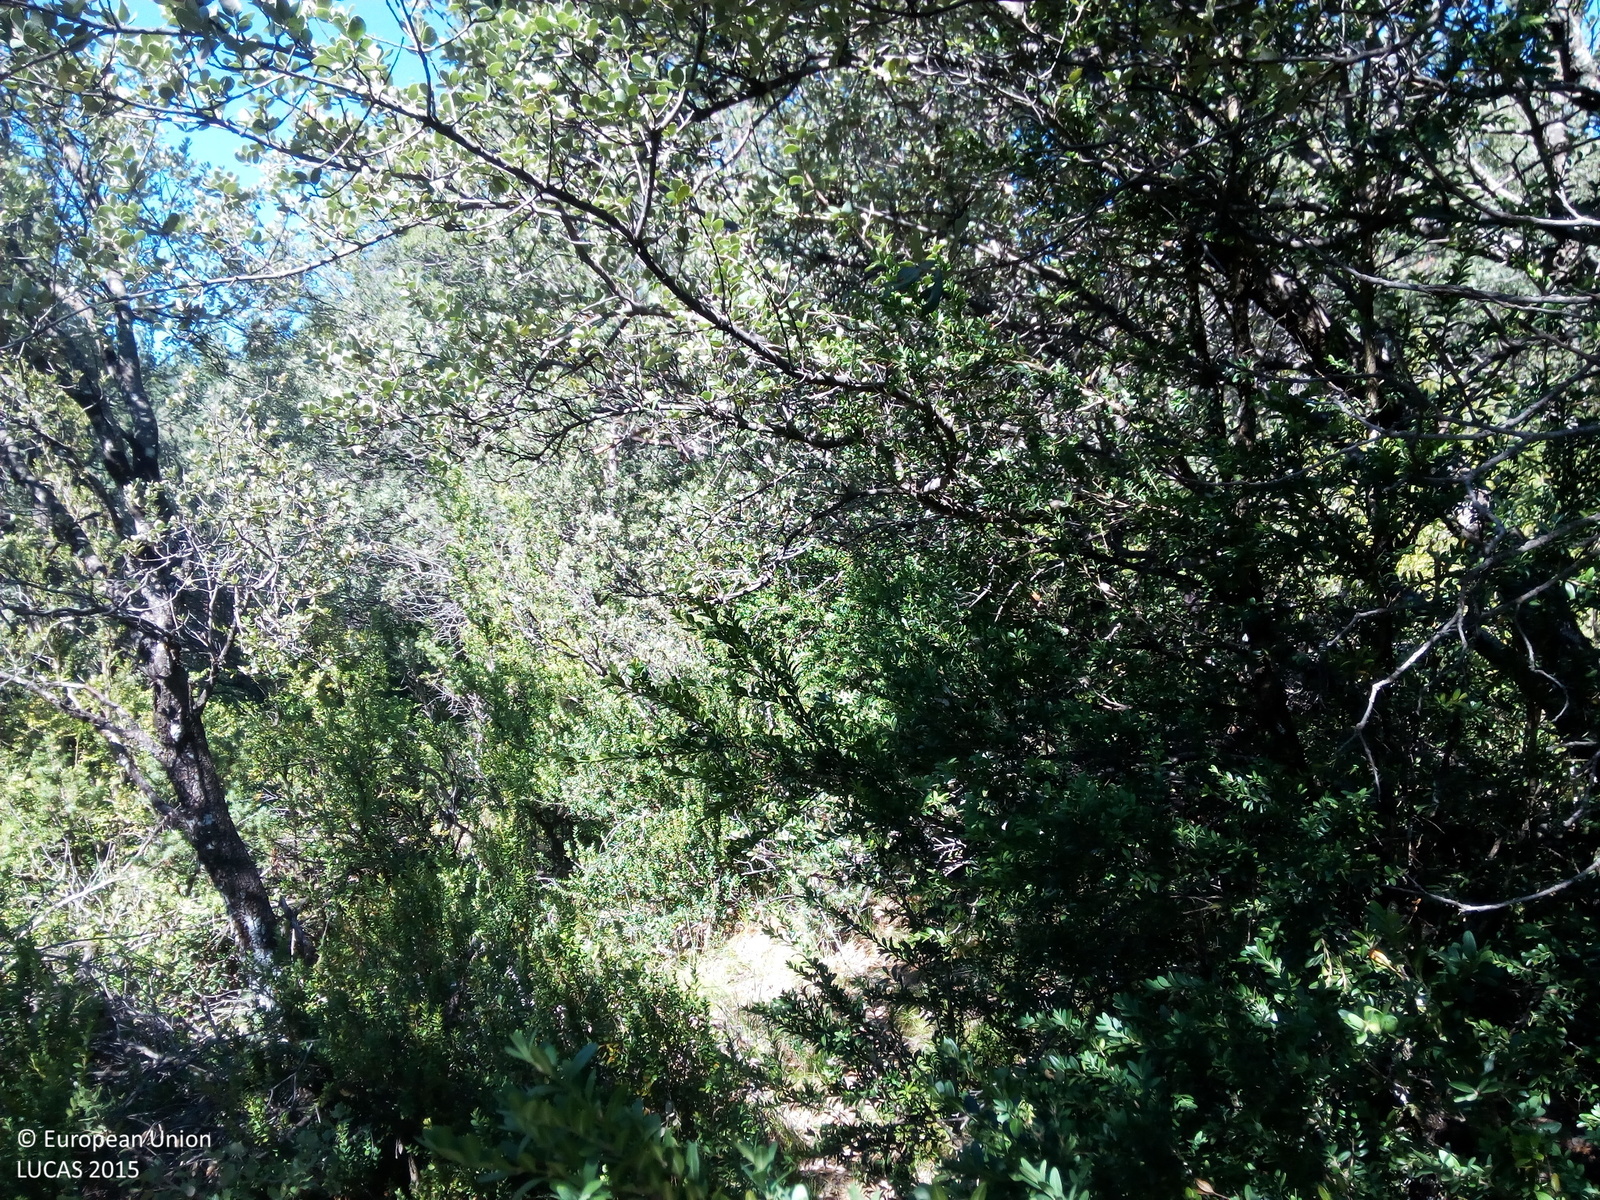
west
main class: Woodland
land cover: Pine dominated mixed woodland
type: alpine coniferous forest
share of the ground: > 75 %
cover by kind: broadleaved forest trees 40 %, coniferous forest trees 30 %, shrubs 20 %, herbaceous plants 10 %
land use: Semi-natural and natural areas not in use
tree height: > 5 m
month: August
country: ES
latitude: 42.5771
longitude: 0.1946
